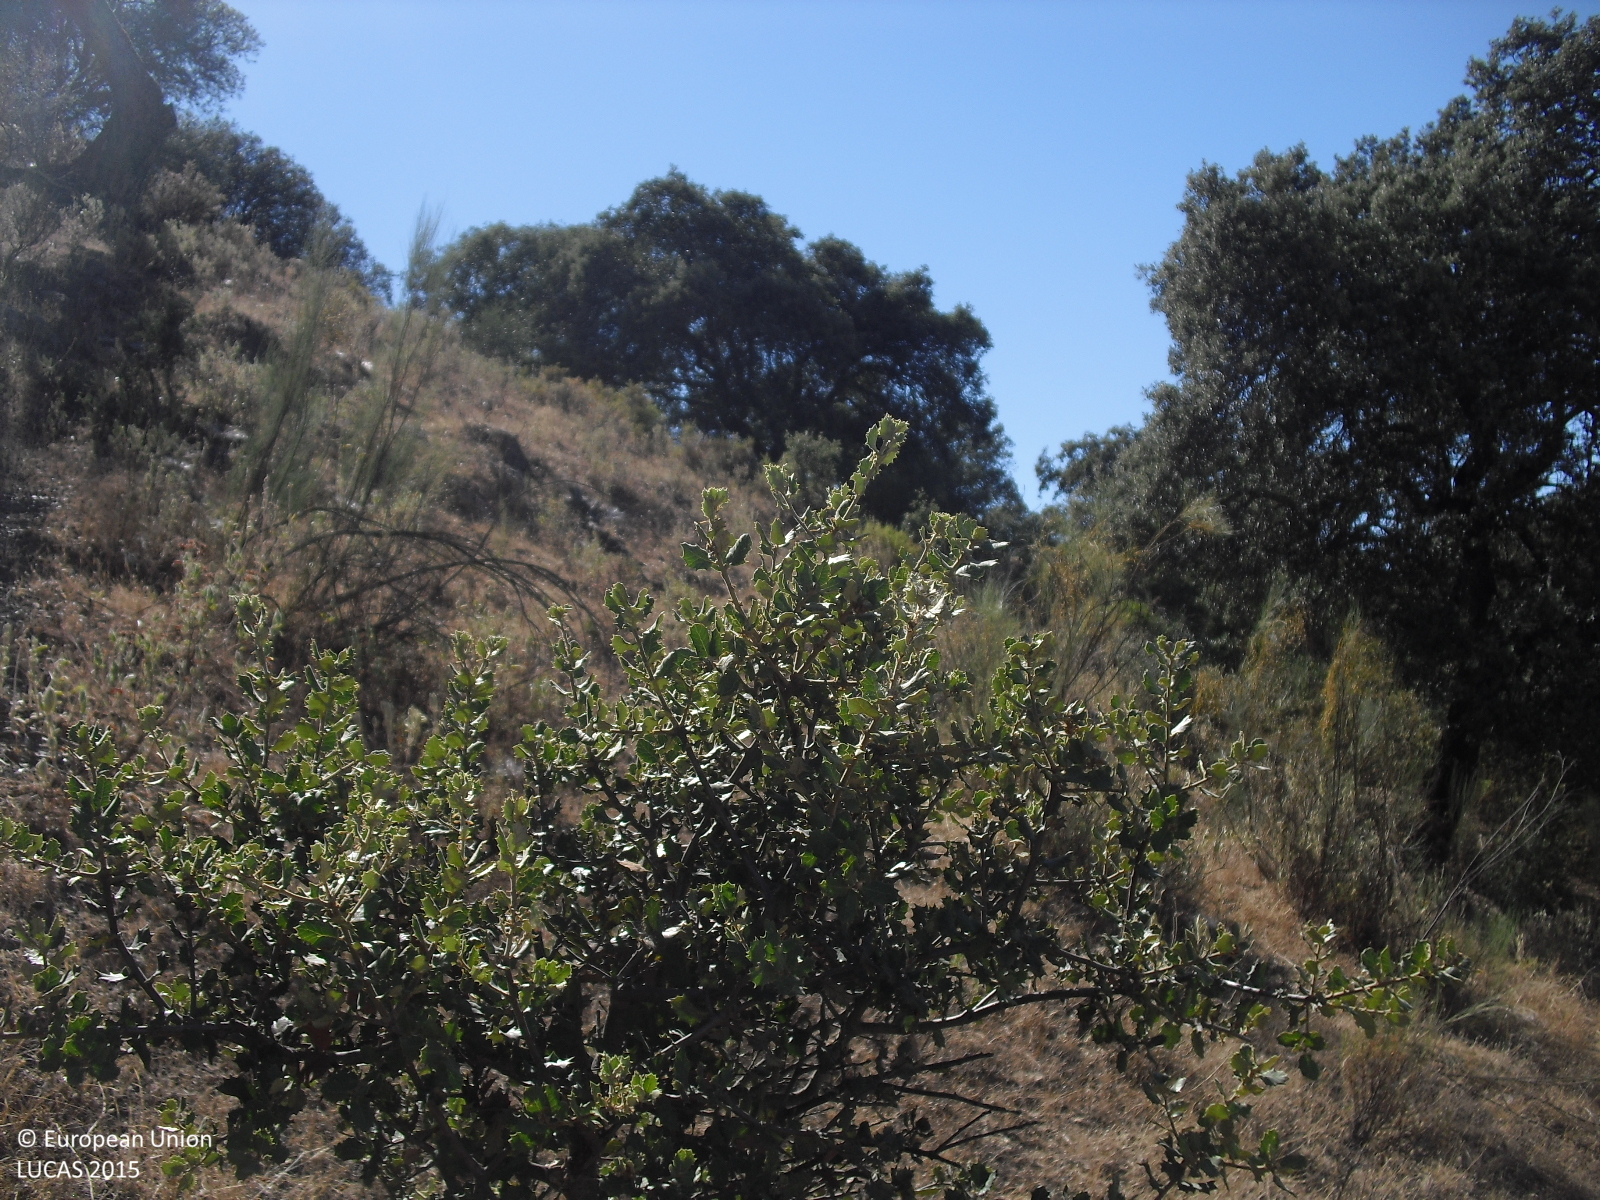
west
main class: Woodland
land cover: Broadleaved woodland
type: broadleaved evergreen forest
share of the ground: 10 - 25 %
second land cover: Shrubland without tree cover
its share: 25 - 50 %
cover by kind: herbaceous plants 55 %, shrubs 30 %, broadleaved forest trees 10 %, unconsolidated bare surface 5 %
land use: Forestry
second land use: Agriculture (excluding fallow land and kitchen gardens)
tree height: < 5 m
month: July
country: ES
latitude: 37.0877
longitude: -5.3189
